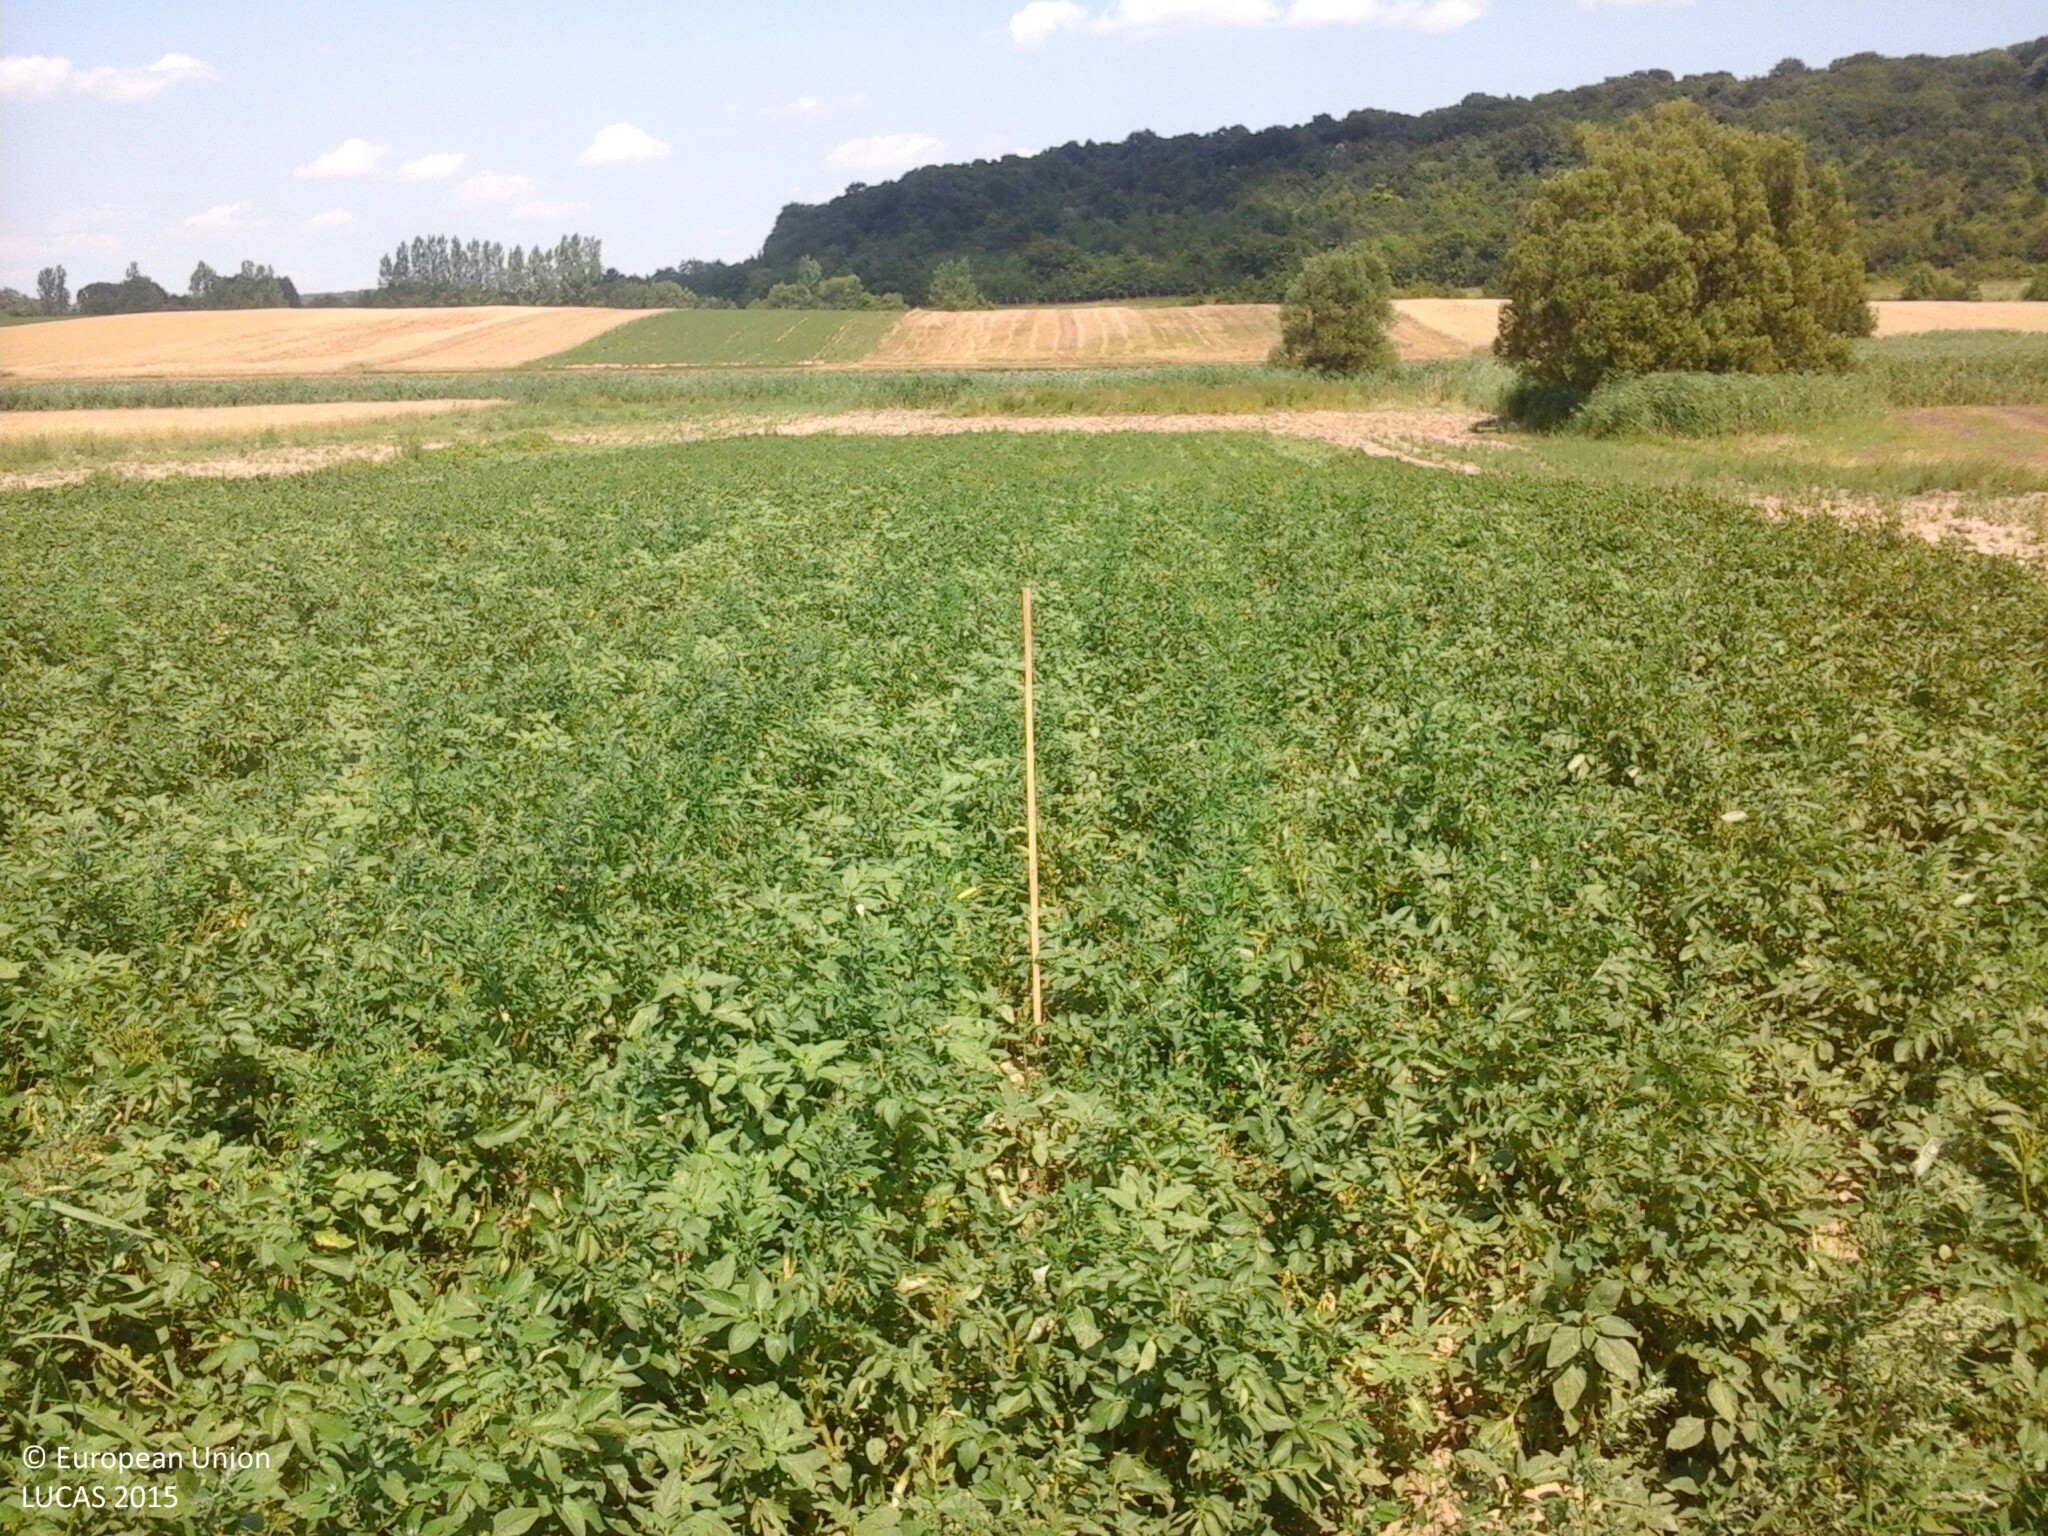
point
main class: Cropland
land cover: Potatoes
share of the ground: > 75 %
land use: Agriculture (excluding fallow land and kitchen gardens)
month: July
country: HU
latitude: 47.2330
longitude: 17.9214
